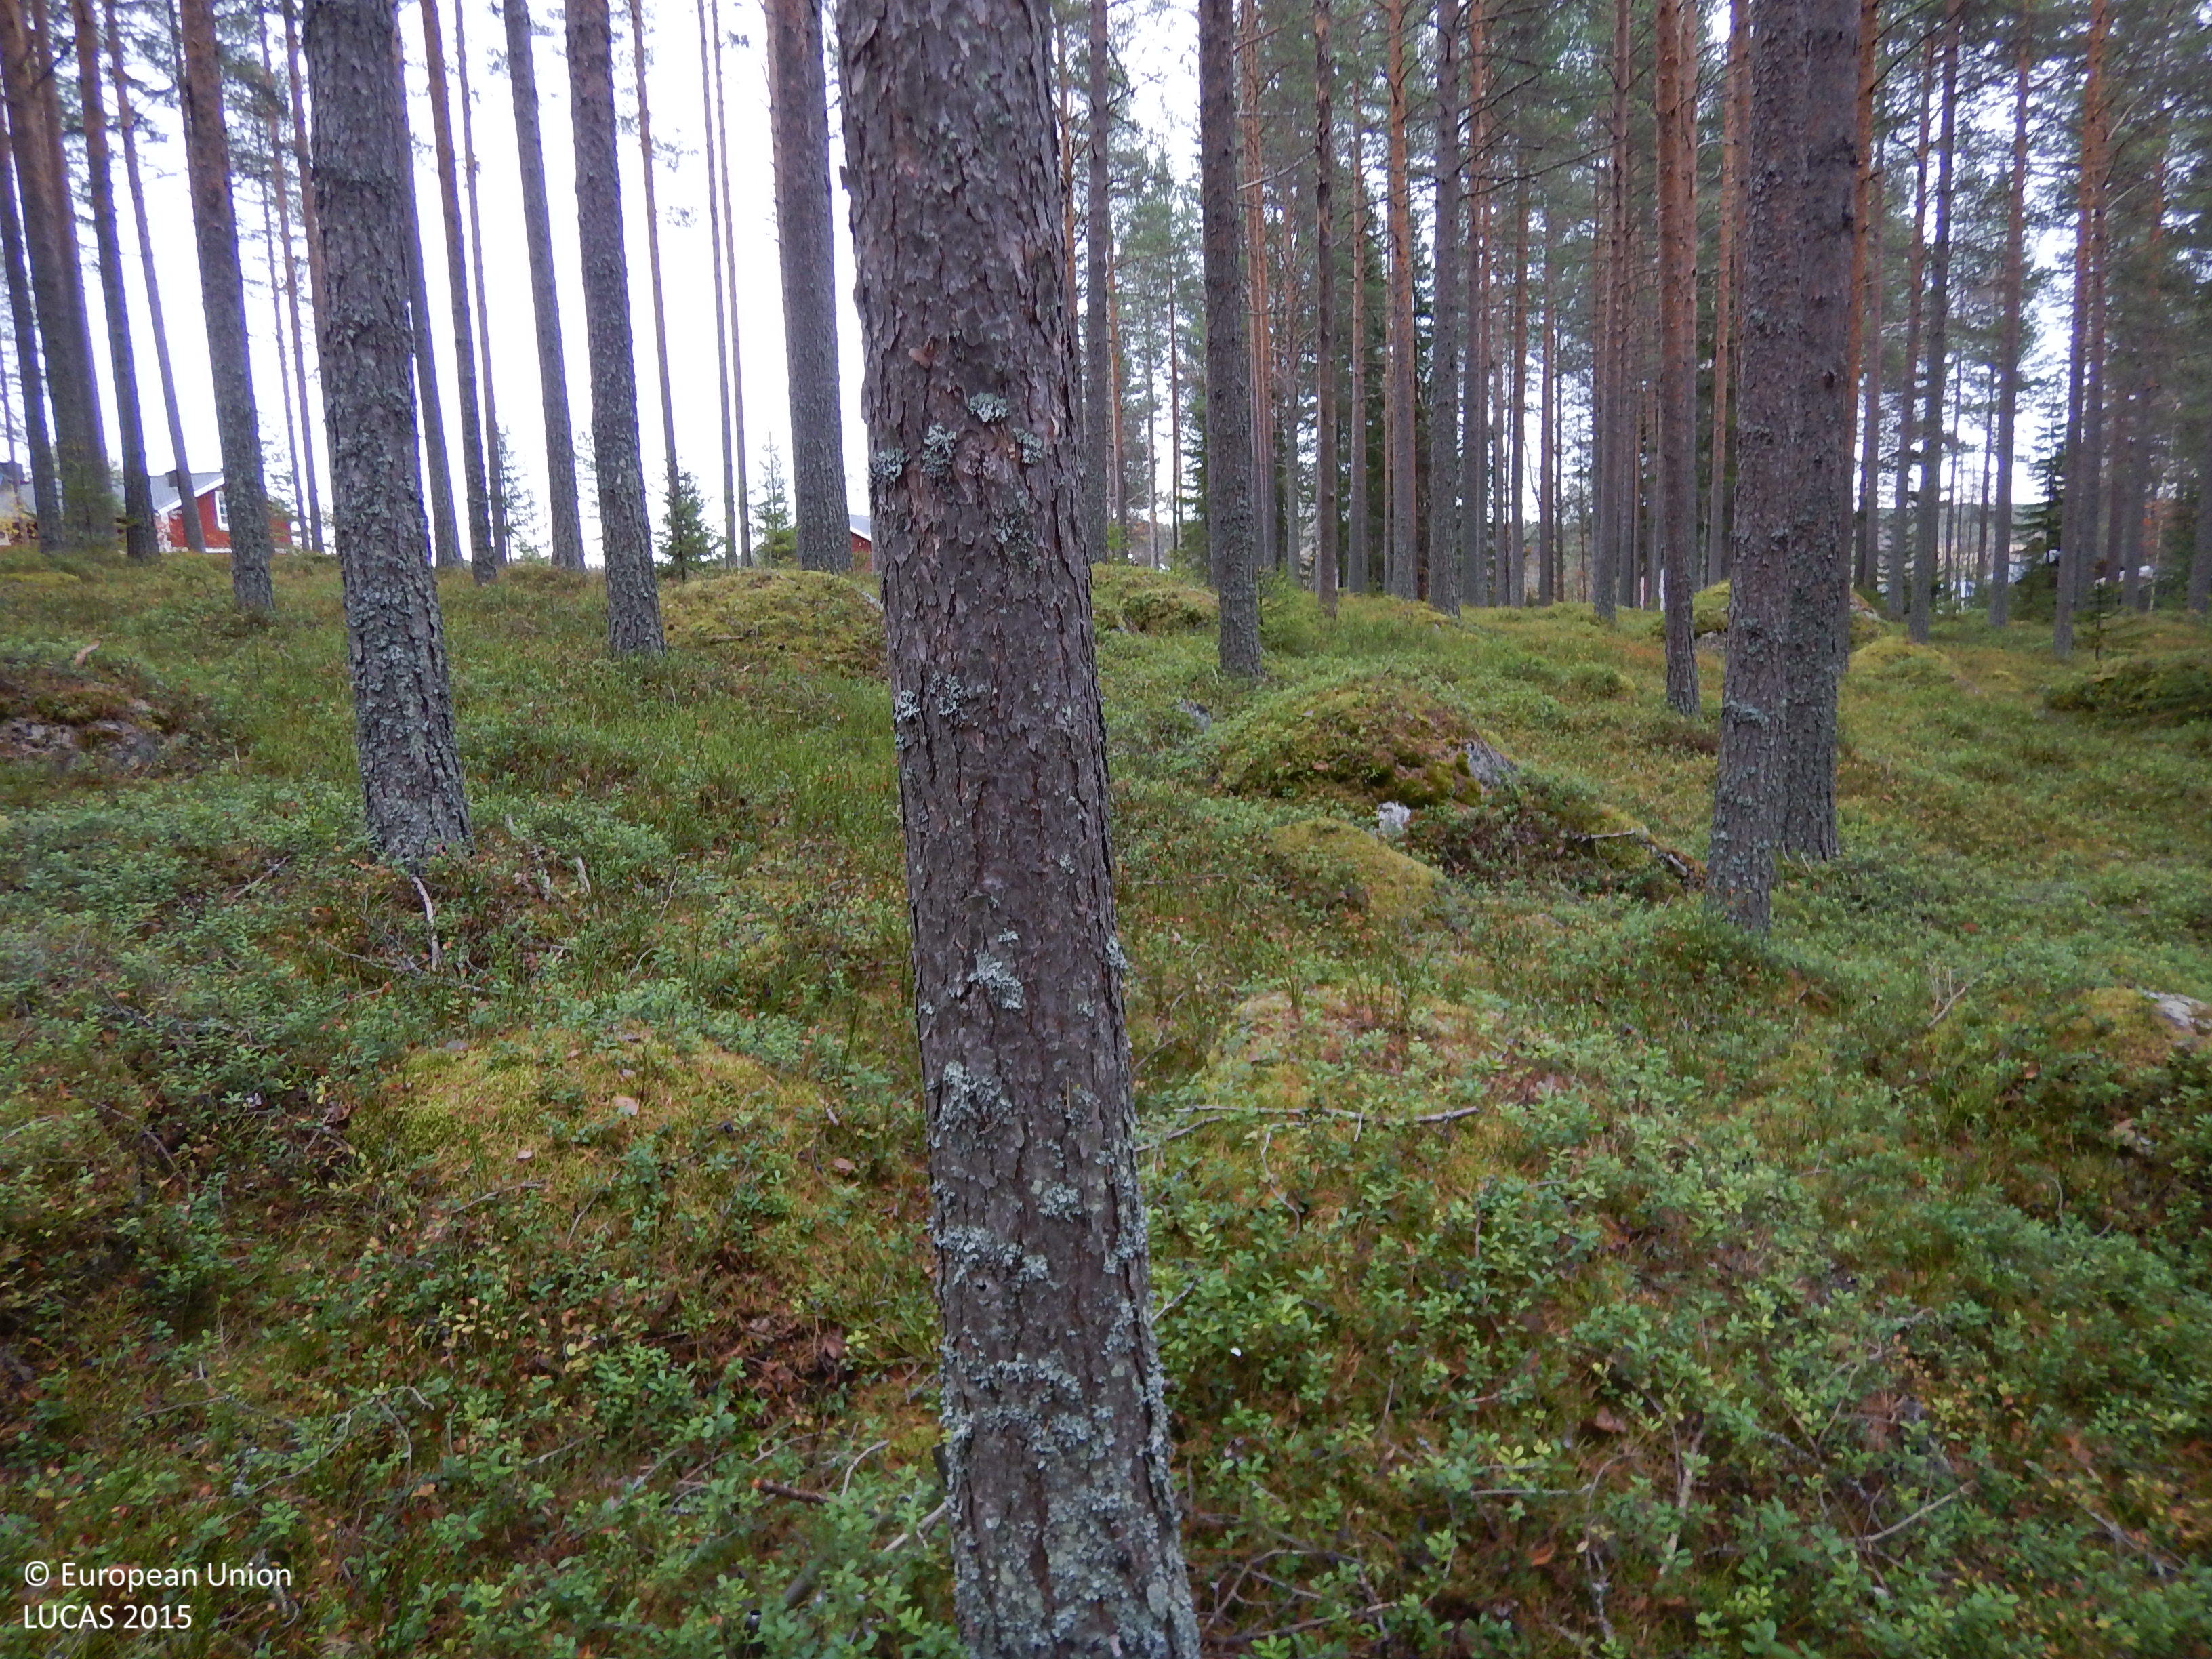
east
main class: Woodland
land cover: Pine dominated coniferous woodland
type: boreal forest
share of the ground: 50 - 75 %
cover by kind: coniferous forest trees 55 %, shrubs 15 %, herbaceous plants 15 %, lichens and mosses 15 %
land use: Forestry
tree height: > 5 m
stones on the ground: < 10 %
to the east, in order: Pine dominated coniferous woodland; Tracks; Pine dominated coniferous woodland; Artificial constructions in urban areas; Grassland without tree/shrub cover; Electric lines; Ditches and canals; Paved roads, cycling and walking lanes; Grassland without tree/shrub cover
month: October
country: SE
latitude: 65.1159
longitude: 21.2006
